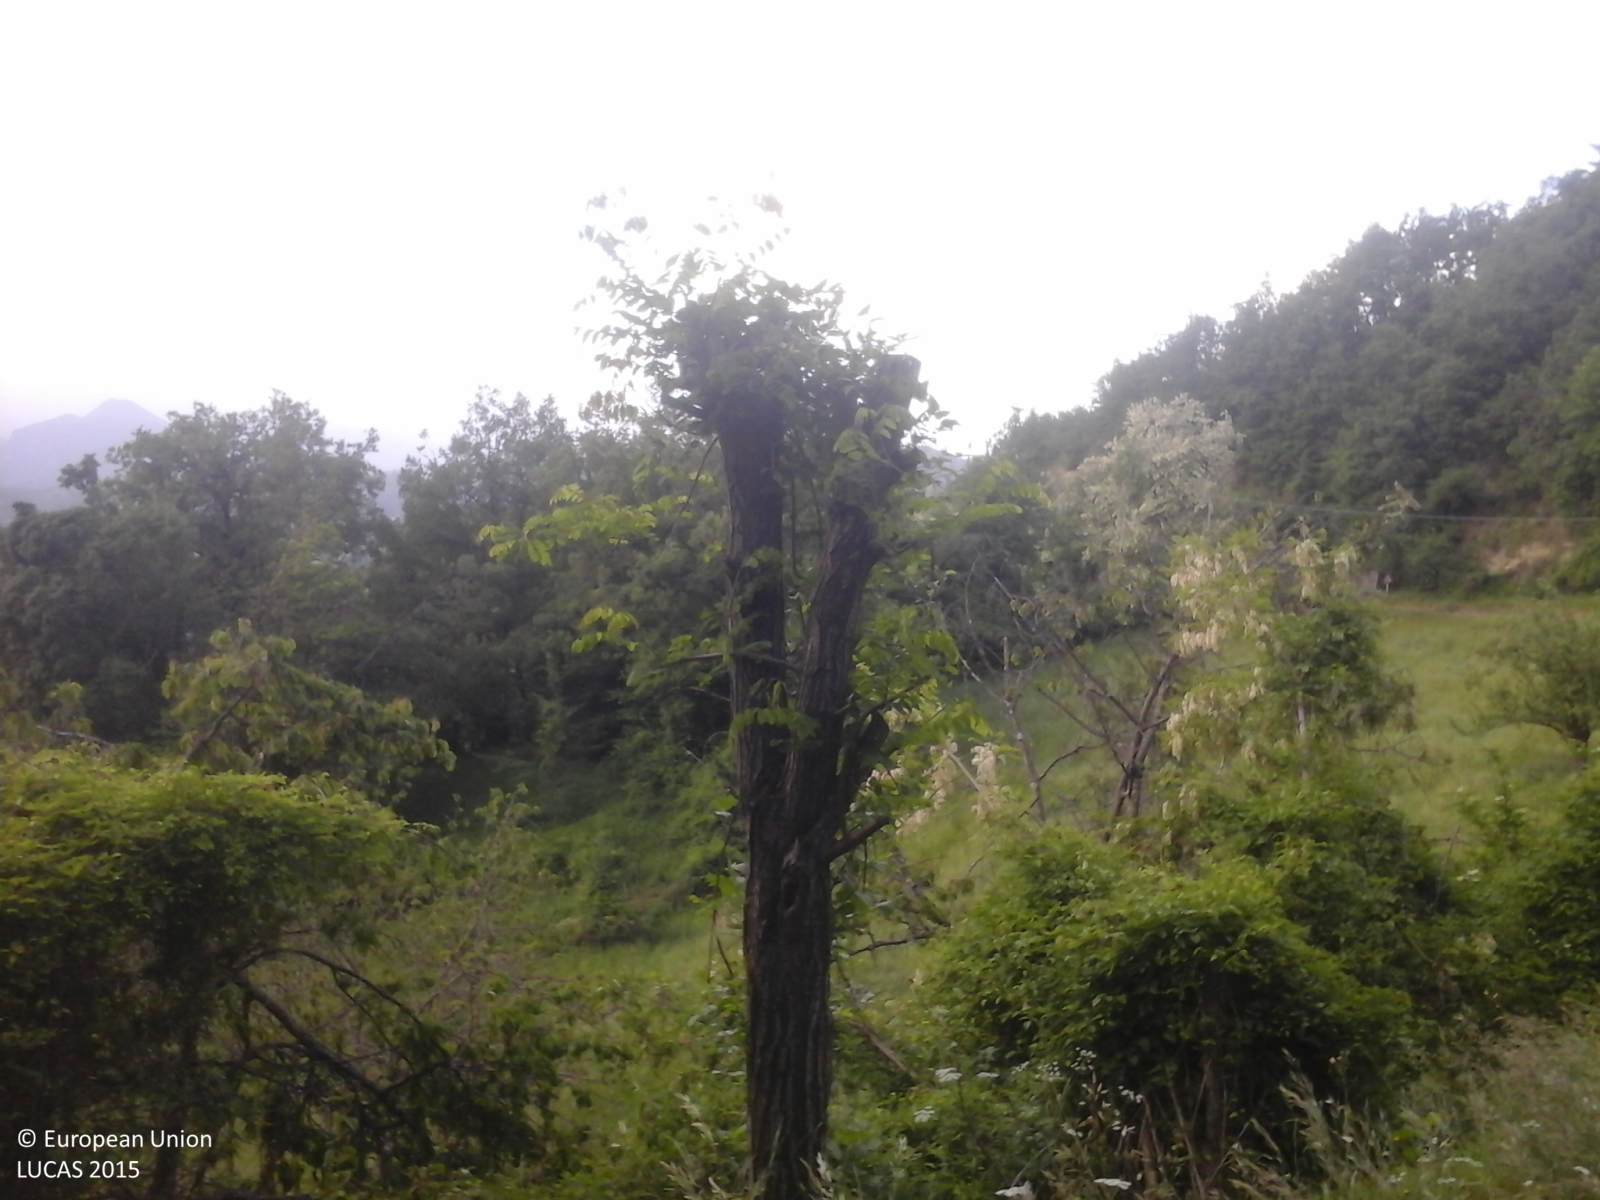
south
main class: Woodland
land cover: Broadleaved woodland
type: thermophilous deciduous forest
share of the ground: > 75 %
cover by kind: broadleaved forest trees 90 %, shrubs 10 %
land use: Forestry
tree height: > 5 m
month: May
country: IT
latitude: 44.3090
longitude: 11.0631
